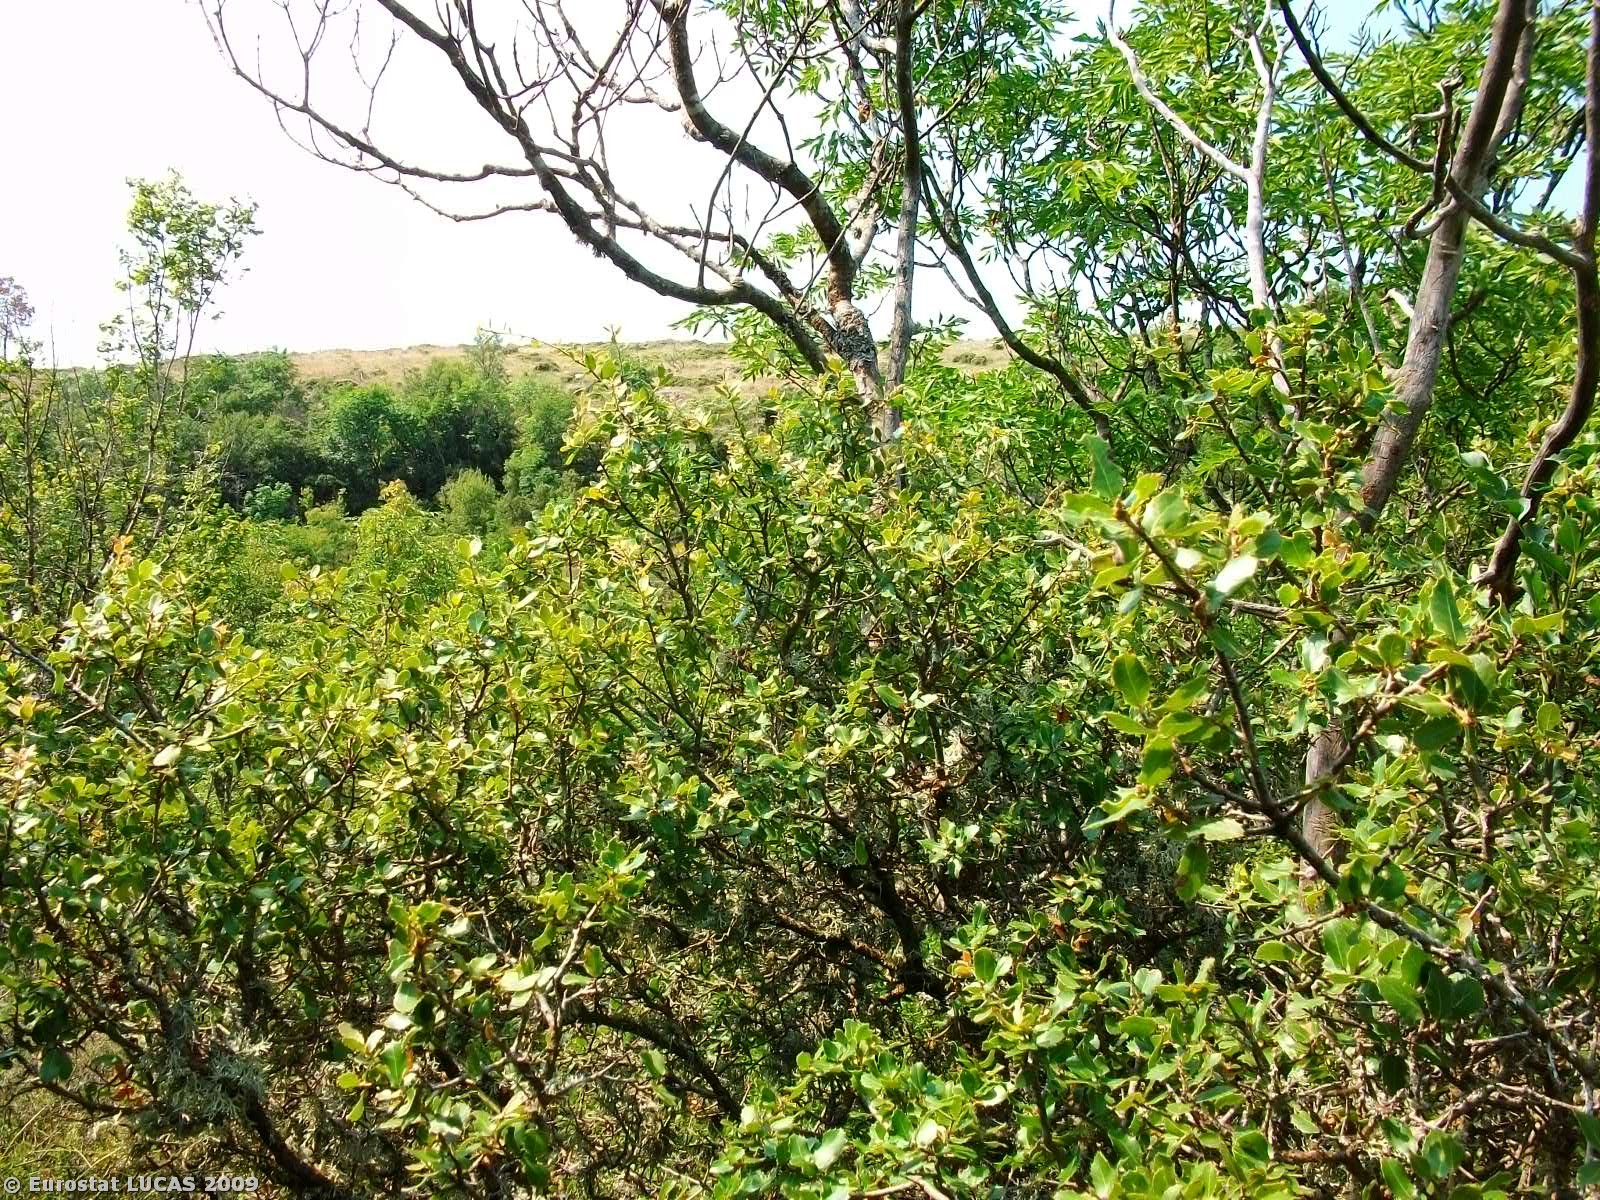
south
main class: Shrubland
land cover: Shrubland with sparse tree cover
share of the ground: > 75 %
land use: Unused
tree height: < 5 m
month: July
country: GR
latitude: 41.0806
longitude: 24.4478
